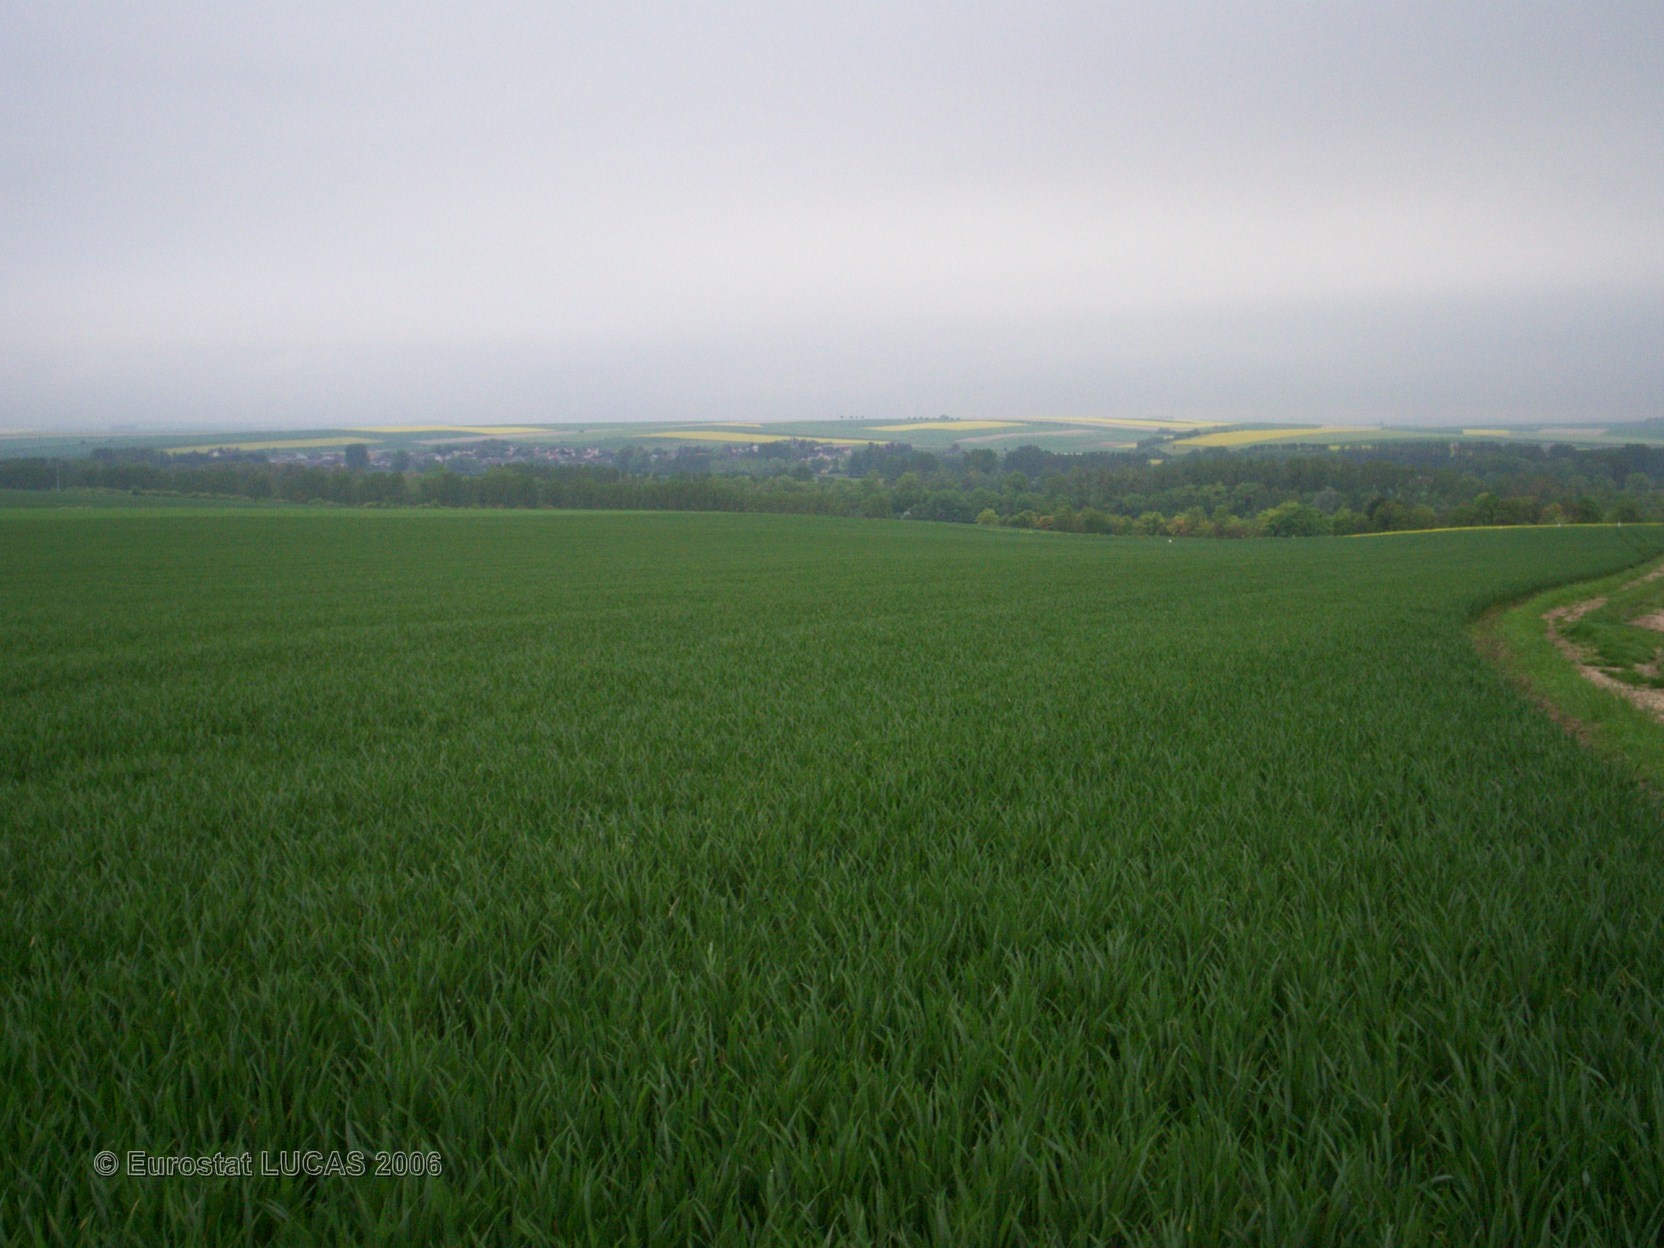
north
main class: Cropland
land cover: Common wheat
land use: Agriculture (excluding fallow land and kitchen gardens)
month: May
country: FR
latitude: 49.5018
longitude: 4.3204
